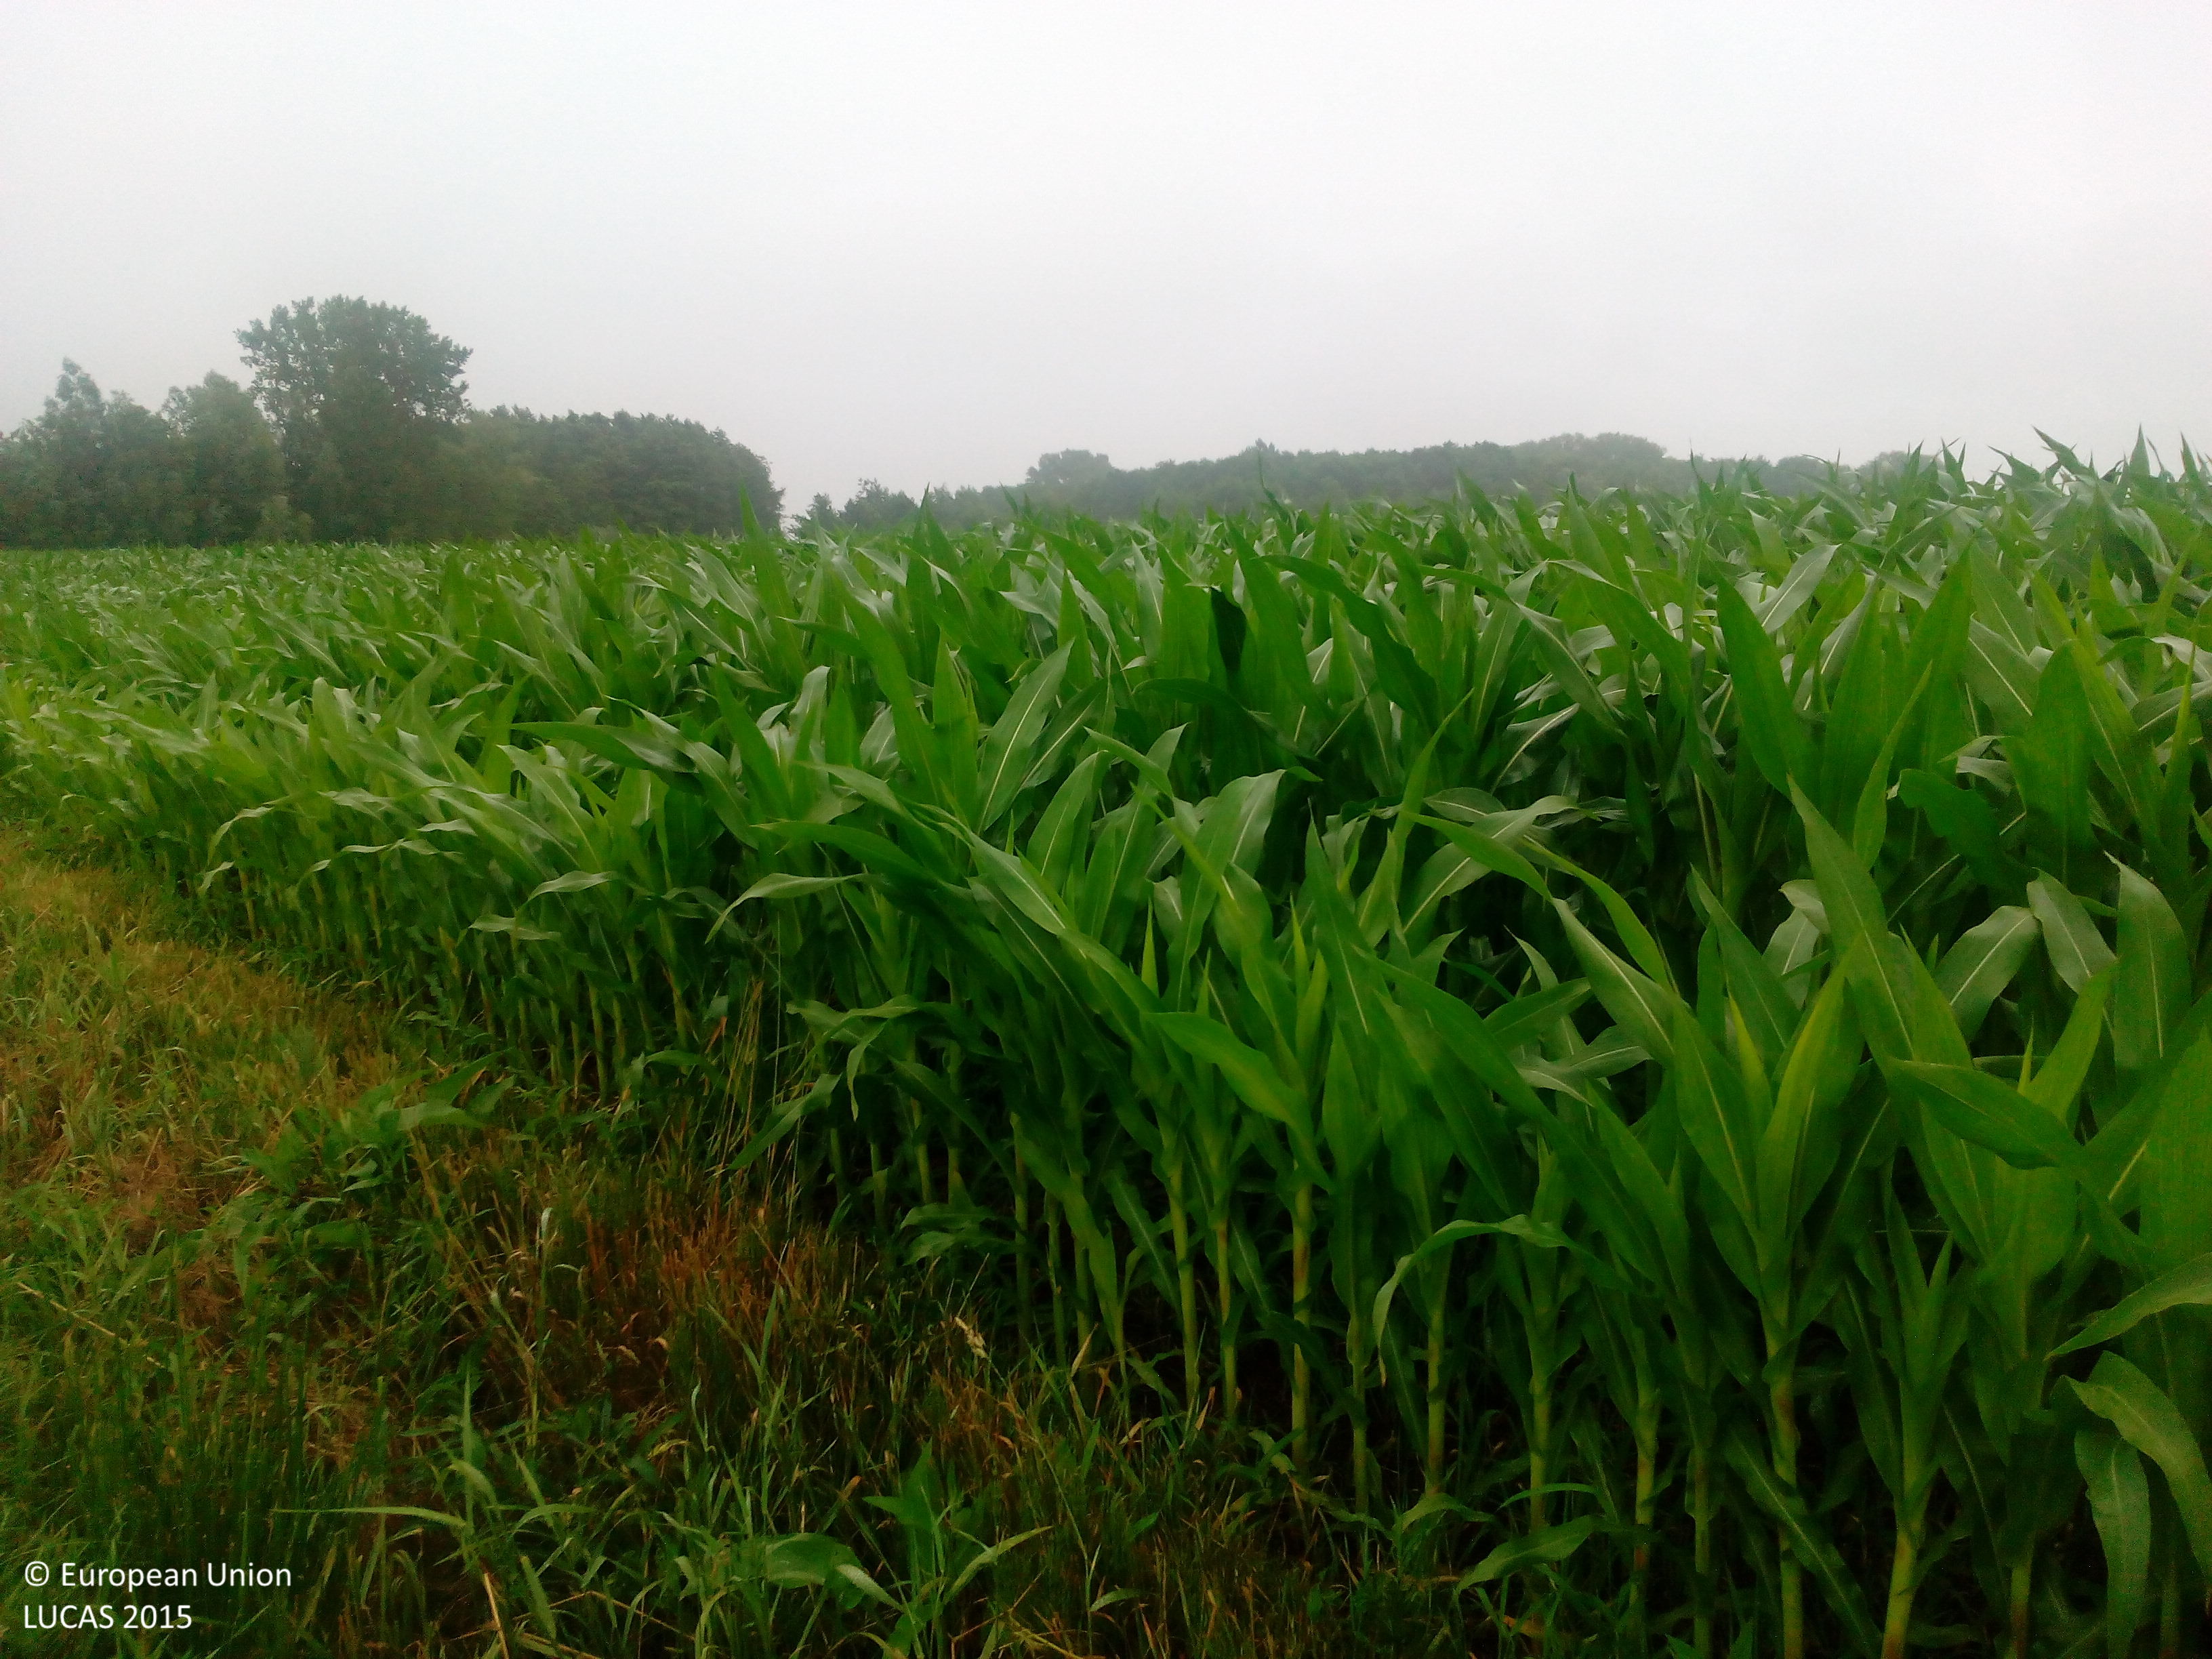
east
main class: Cropland
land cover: Maize
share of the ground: > 75 %
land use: Agriculture (excluding fallow land and kitchen gardens)
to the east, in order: Maize; Fences; Grassland without tree/shrub cover; Fences; Tracks; Fences; Grassland without tree/shrub cover; Fences; Grassland without tree/shrub cover; Inland fresh running water; Broadleaved woodland
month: July
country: NL
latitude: 51.9955
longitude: 6.2855
